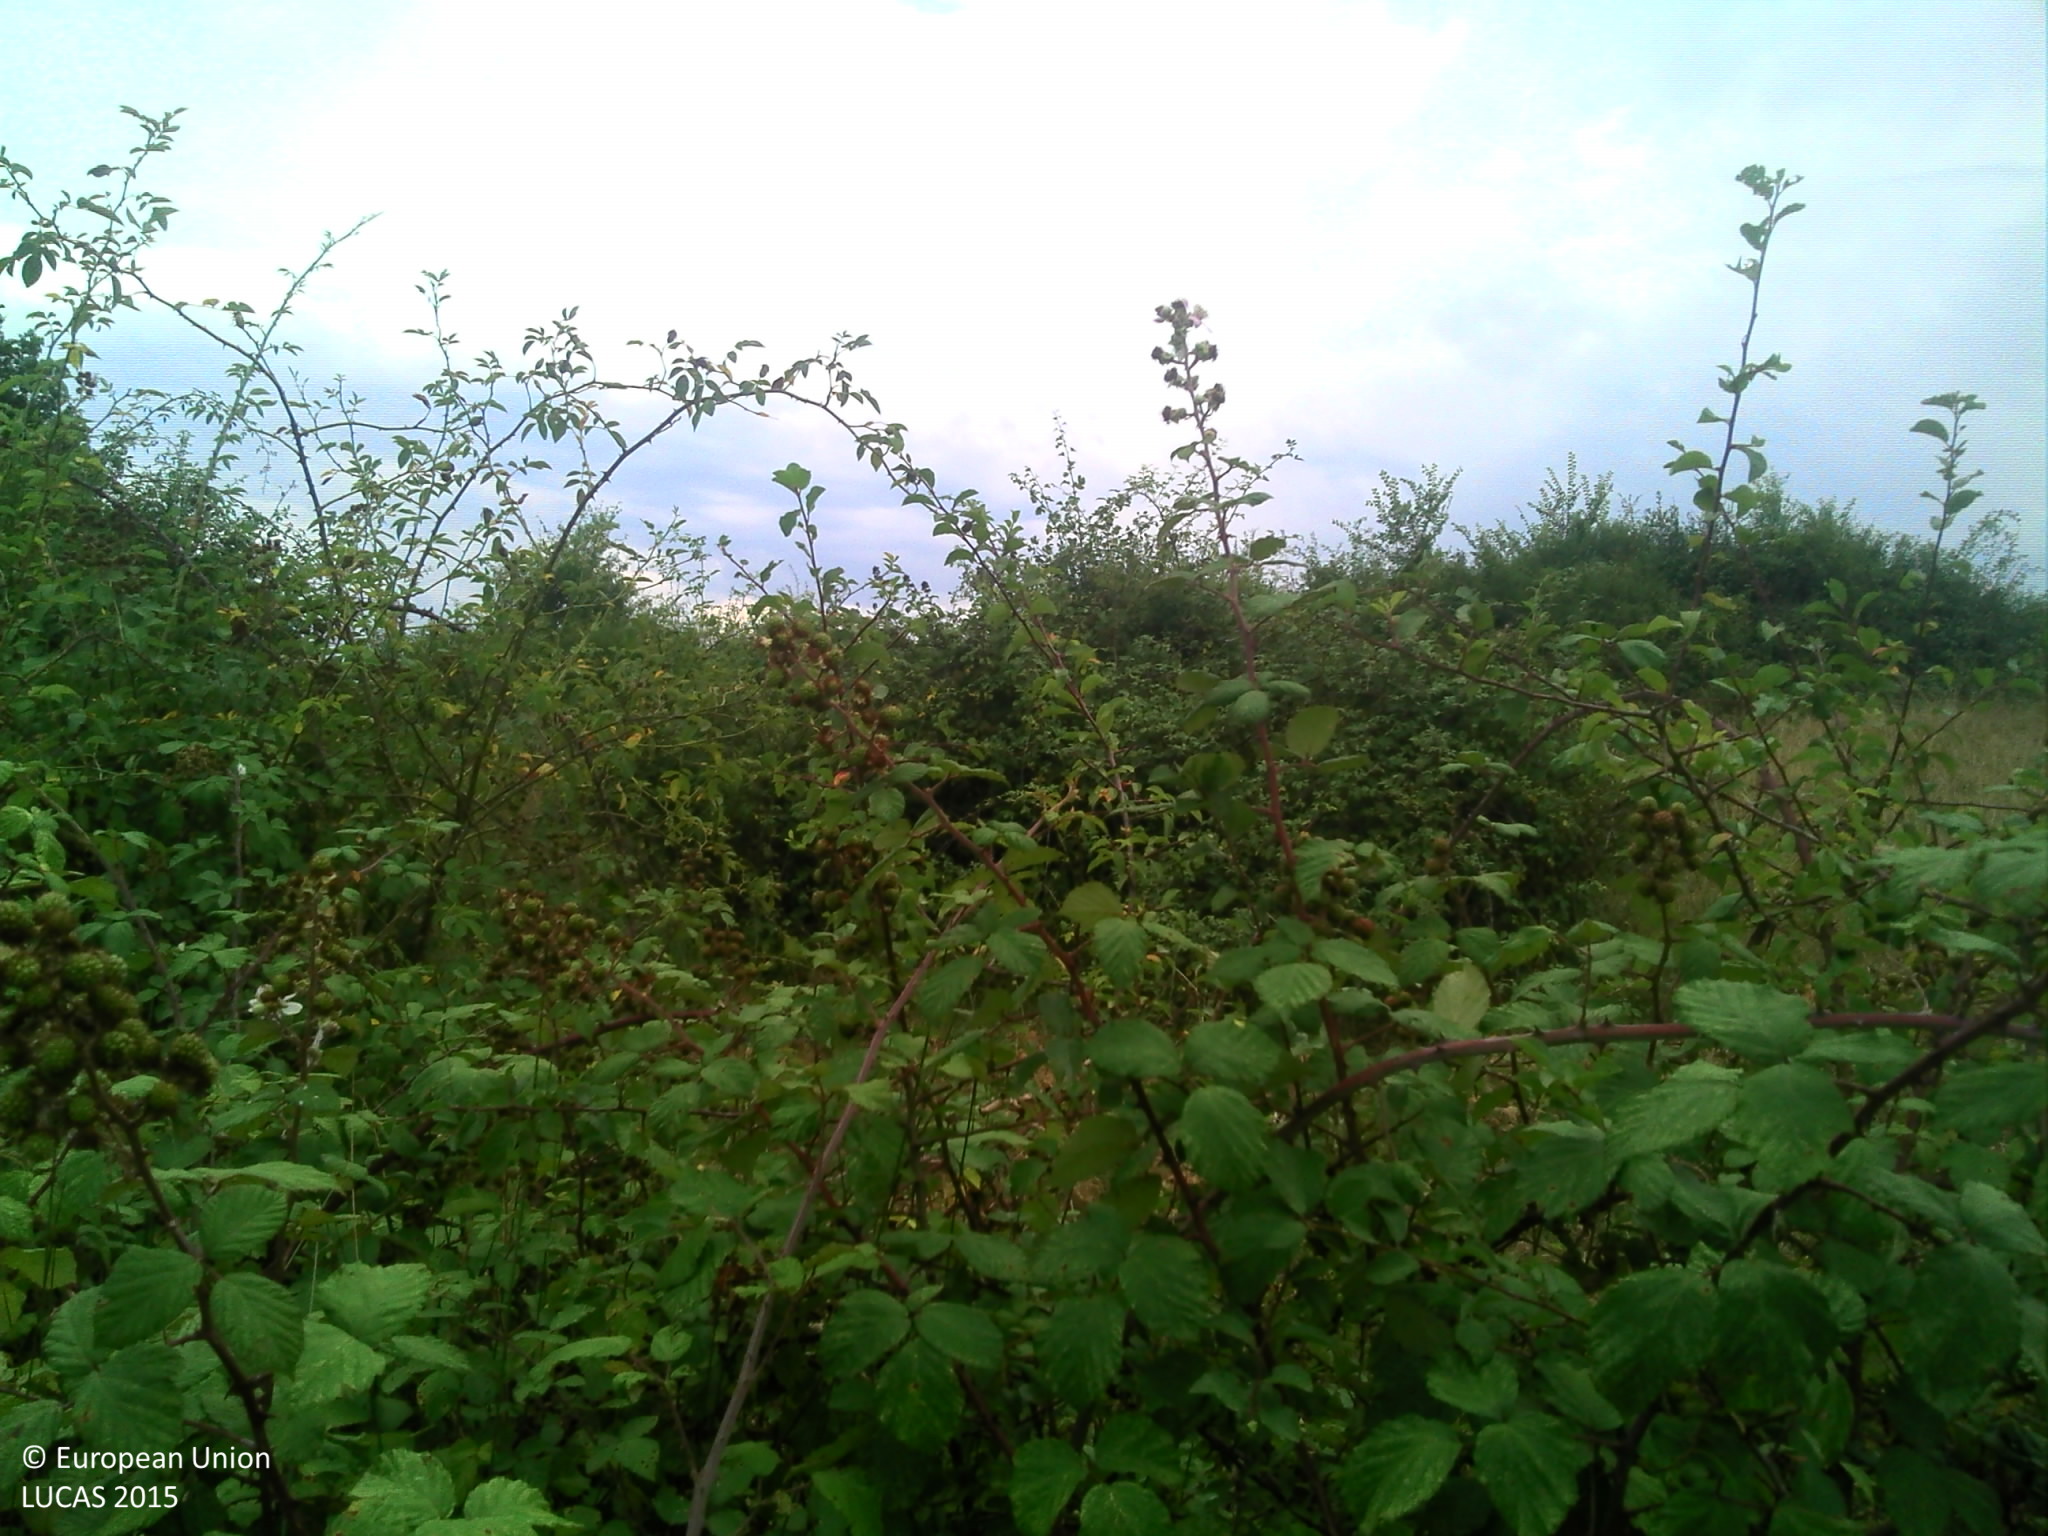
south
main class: Grassland
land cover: Grassland without tree/shrub cover
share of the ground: > 75 %
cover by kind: herbaceous plants 95 %, shrubs 5 %
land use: Agriculture (excluding fallow land and kitchen gardens)
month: July
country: FR
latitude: 43.1419
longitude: 0.7930
